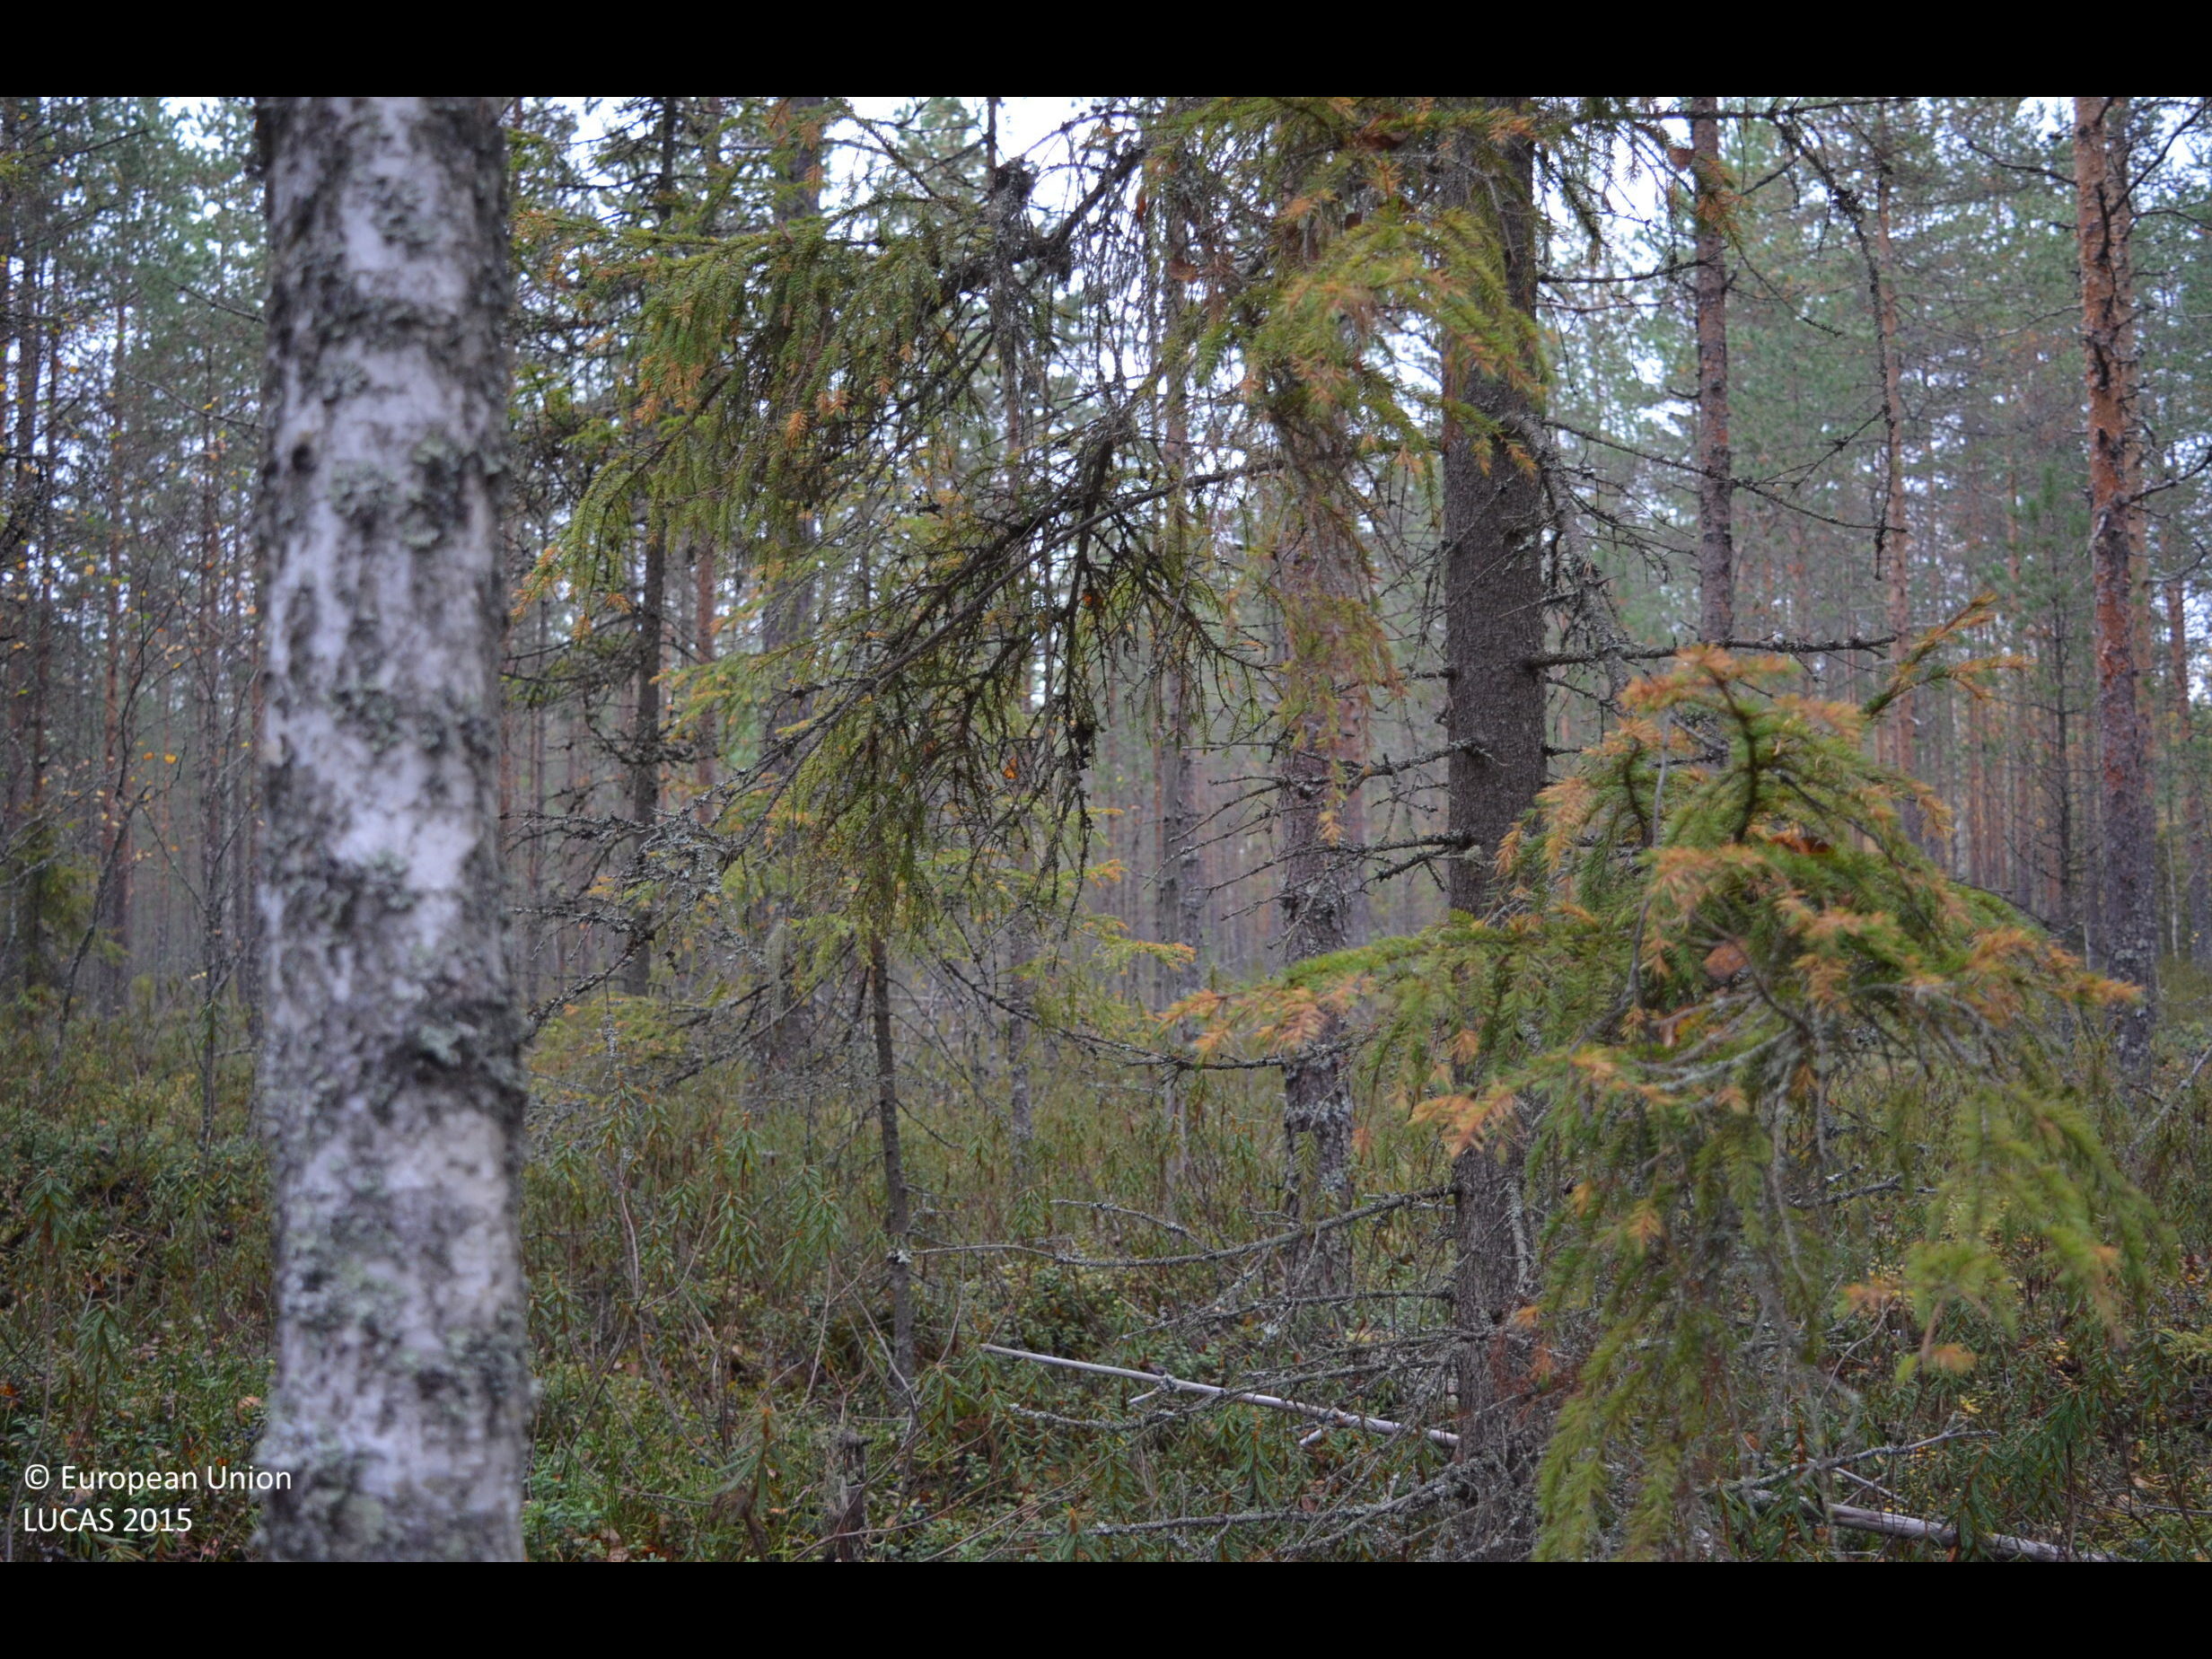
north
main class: Woodland
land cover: Pine dominated coniferous woodland
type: boreal forest
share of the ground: > 75 %
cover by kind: coniferous forest trees 65 %, shrubs 25 %, broadleaved forest trees 10 %
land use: Forestry
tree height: > 5 m
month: September
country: FI
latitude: 62.4732
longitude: 23.7492
